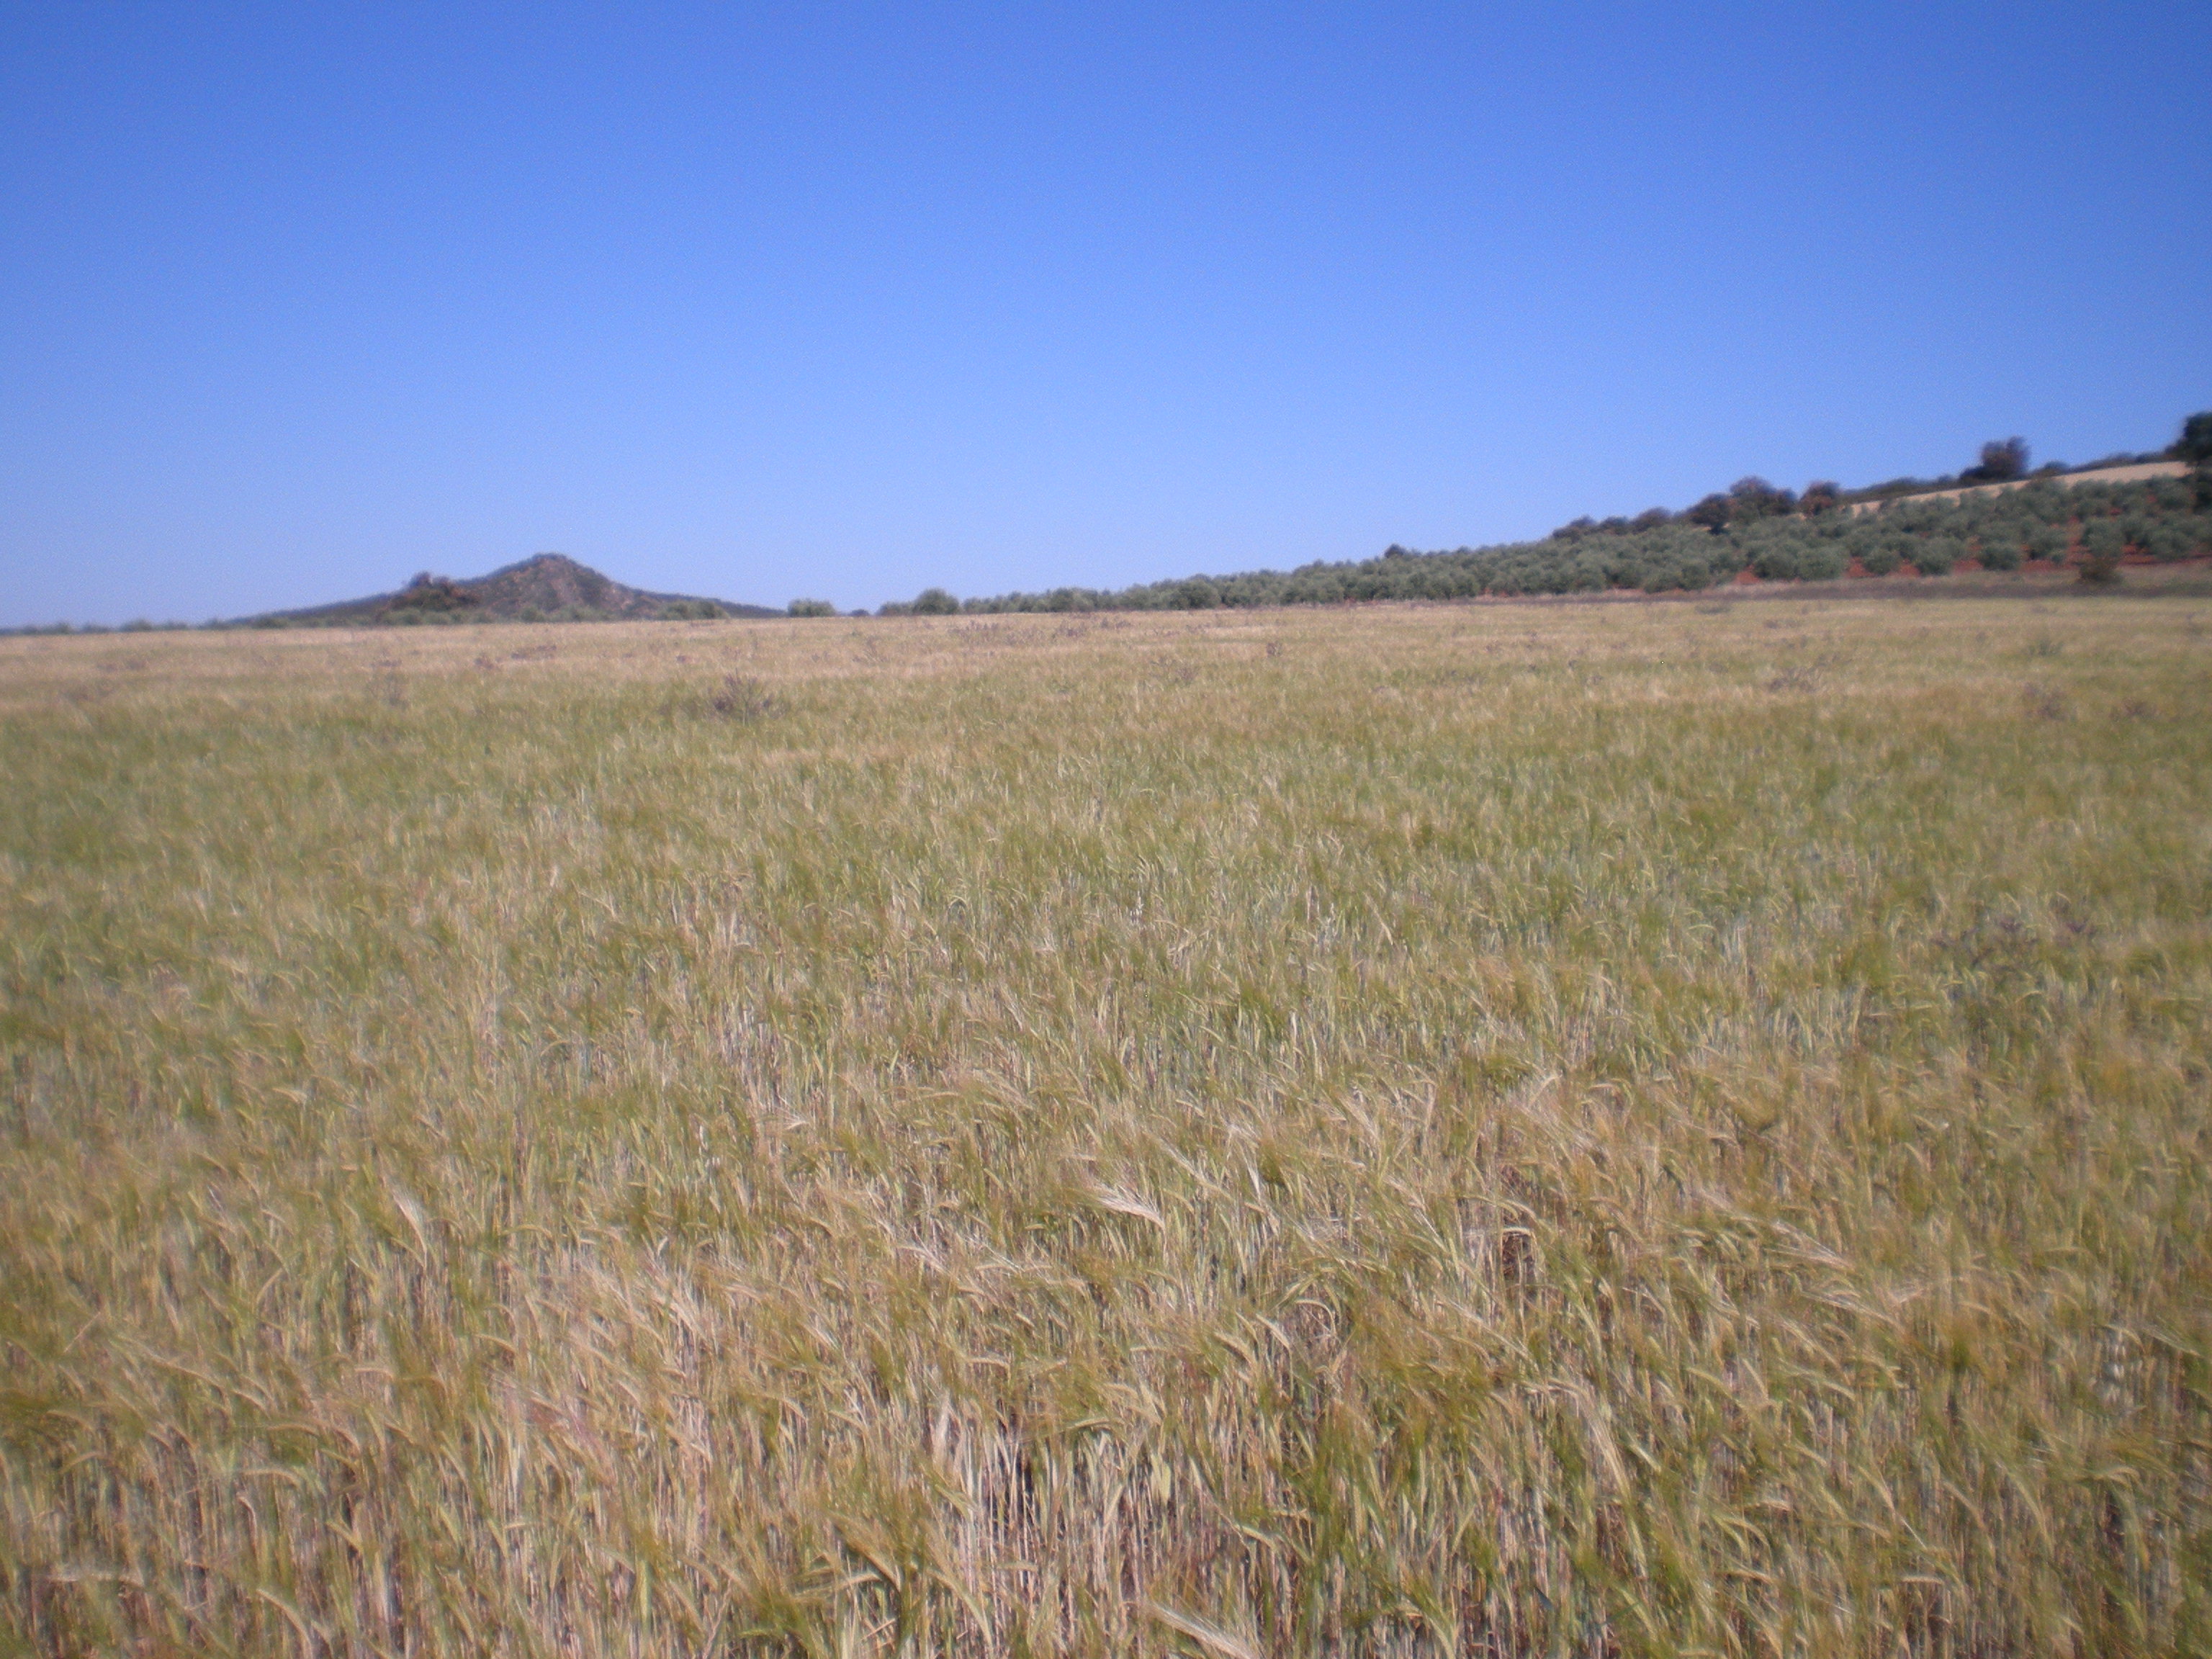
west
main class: Cropland
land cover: Barley
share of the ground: > 75 %
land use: Agriculture (excluding fallow land and kitchen gardens)
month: May
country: ES
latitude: 38.5724
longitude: -3.1481
